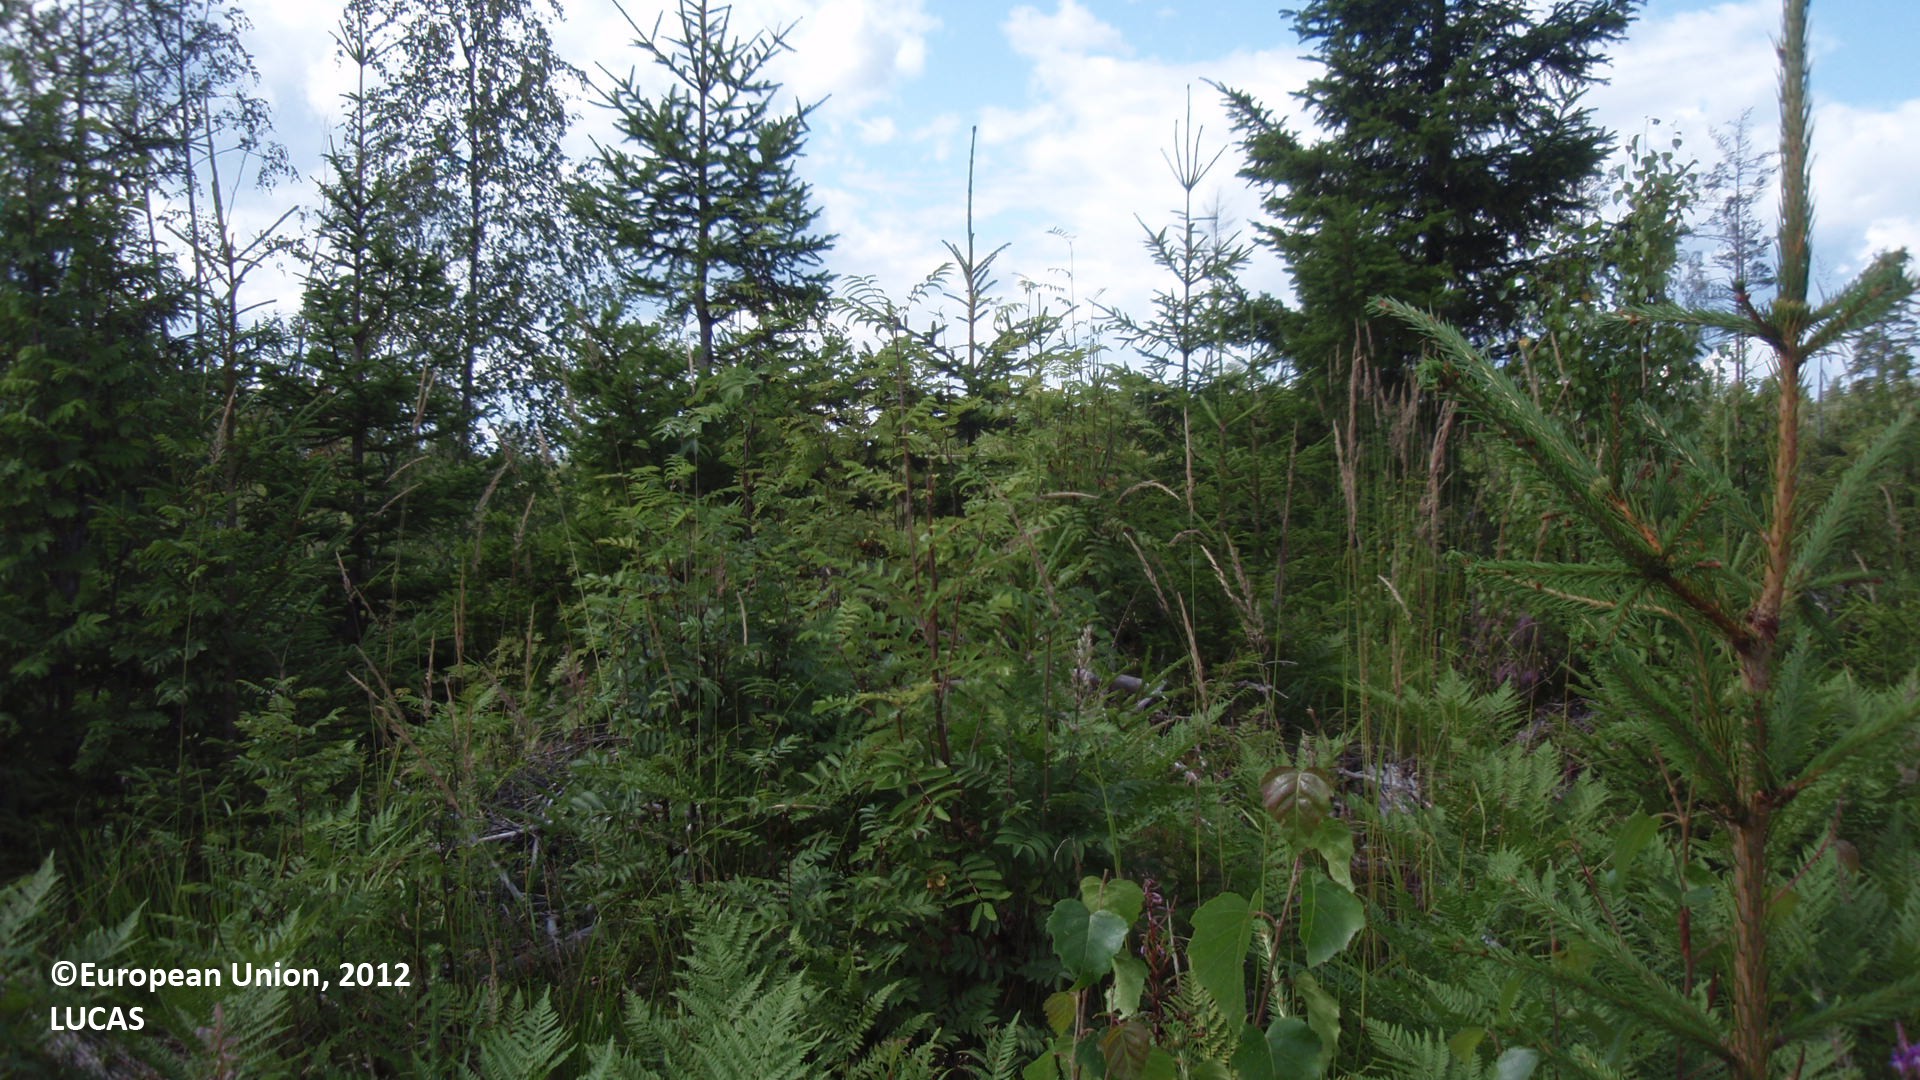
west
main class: Shrubland
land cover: Shrubland with sparse tree cover
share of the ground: > 75 %
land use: Forestry
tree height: < 5 m
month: July
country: FI
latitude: 61.4313
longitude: 28.9174
